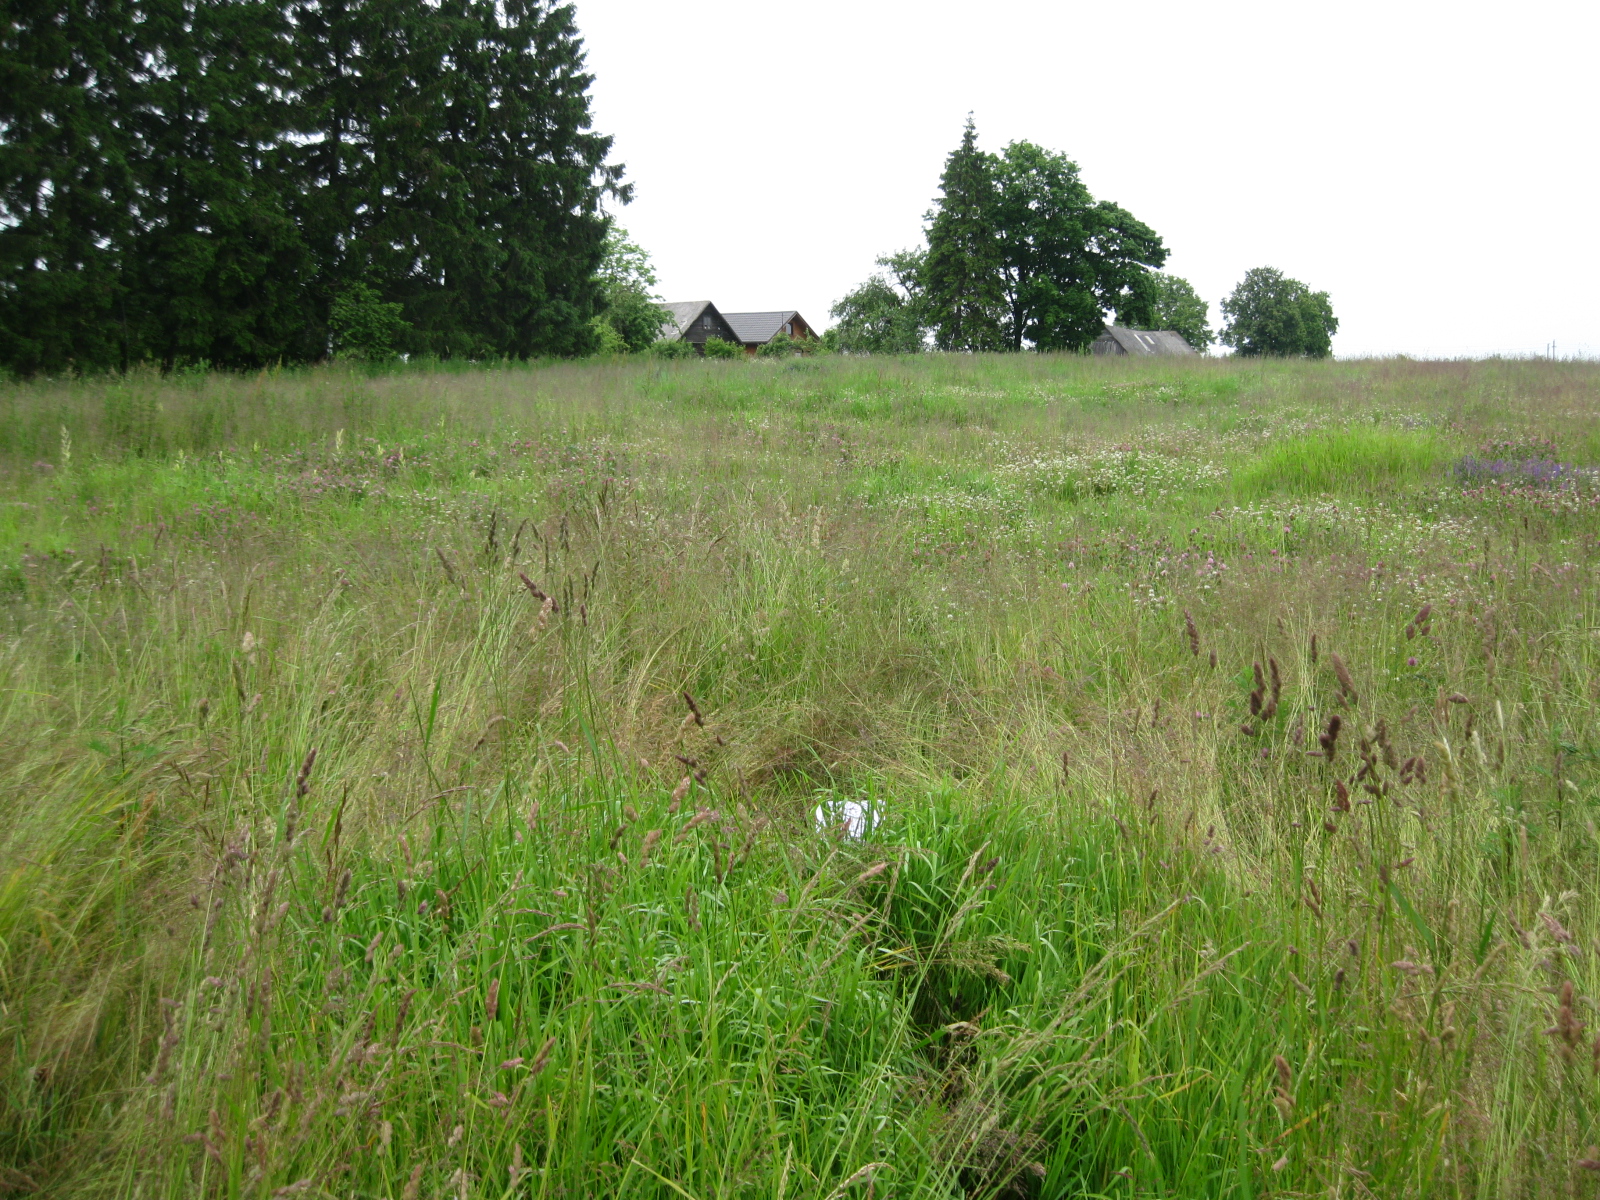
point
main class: Grassland
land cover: Grassland without tree/shrub cover
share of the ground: > 75 %
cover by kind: herbaceous plants 100 %
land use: Agriculture (excluding fallow land and kitchen gardens)
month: June
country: LT
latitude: 55.1894
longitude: 24.0550
